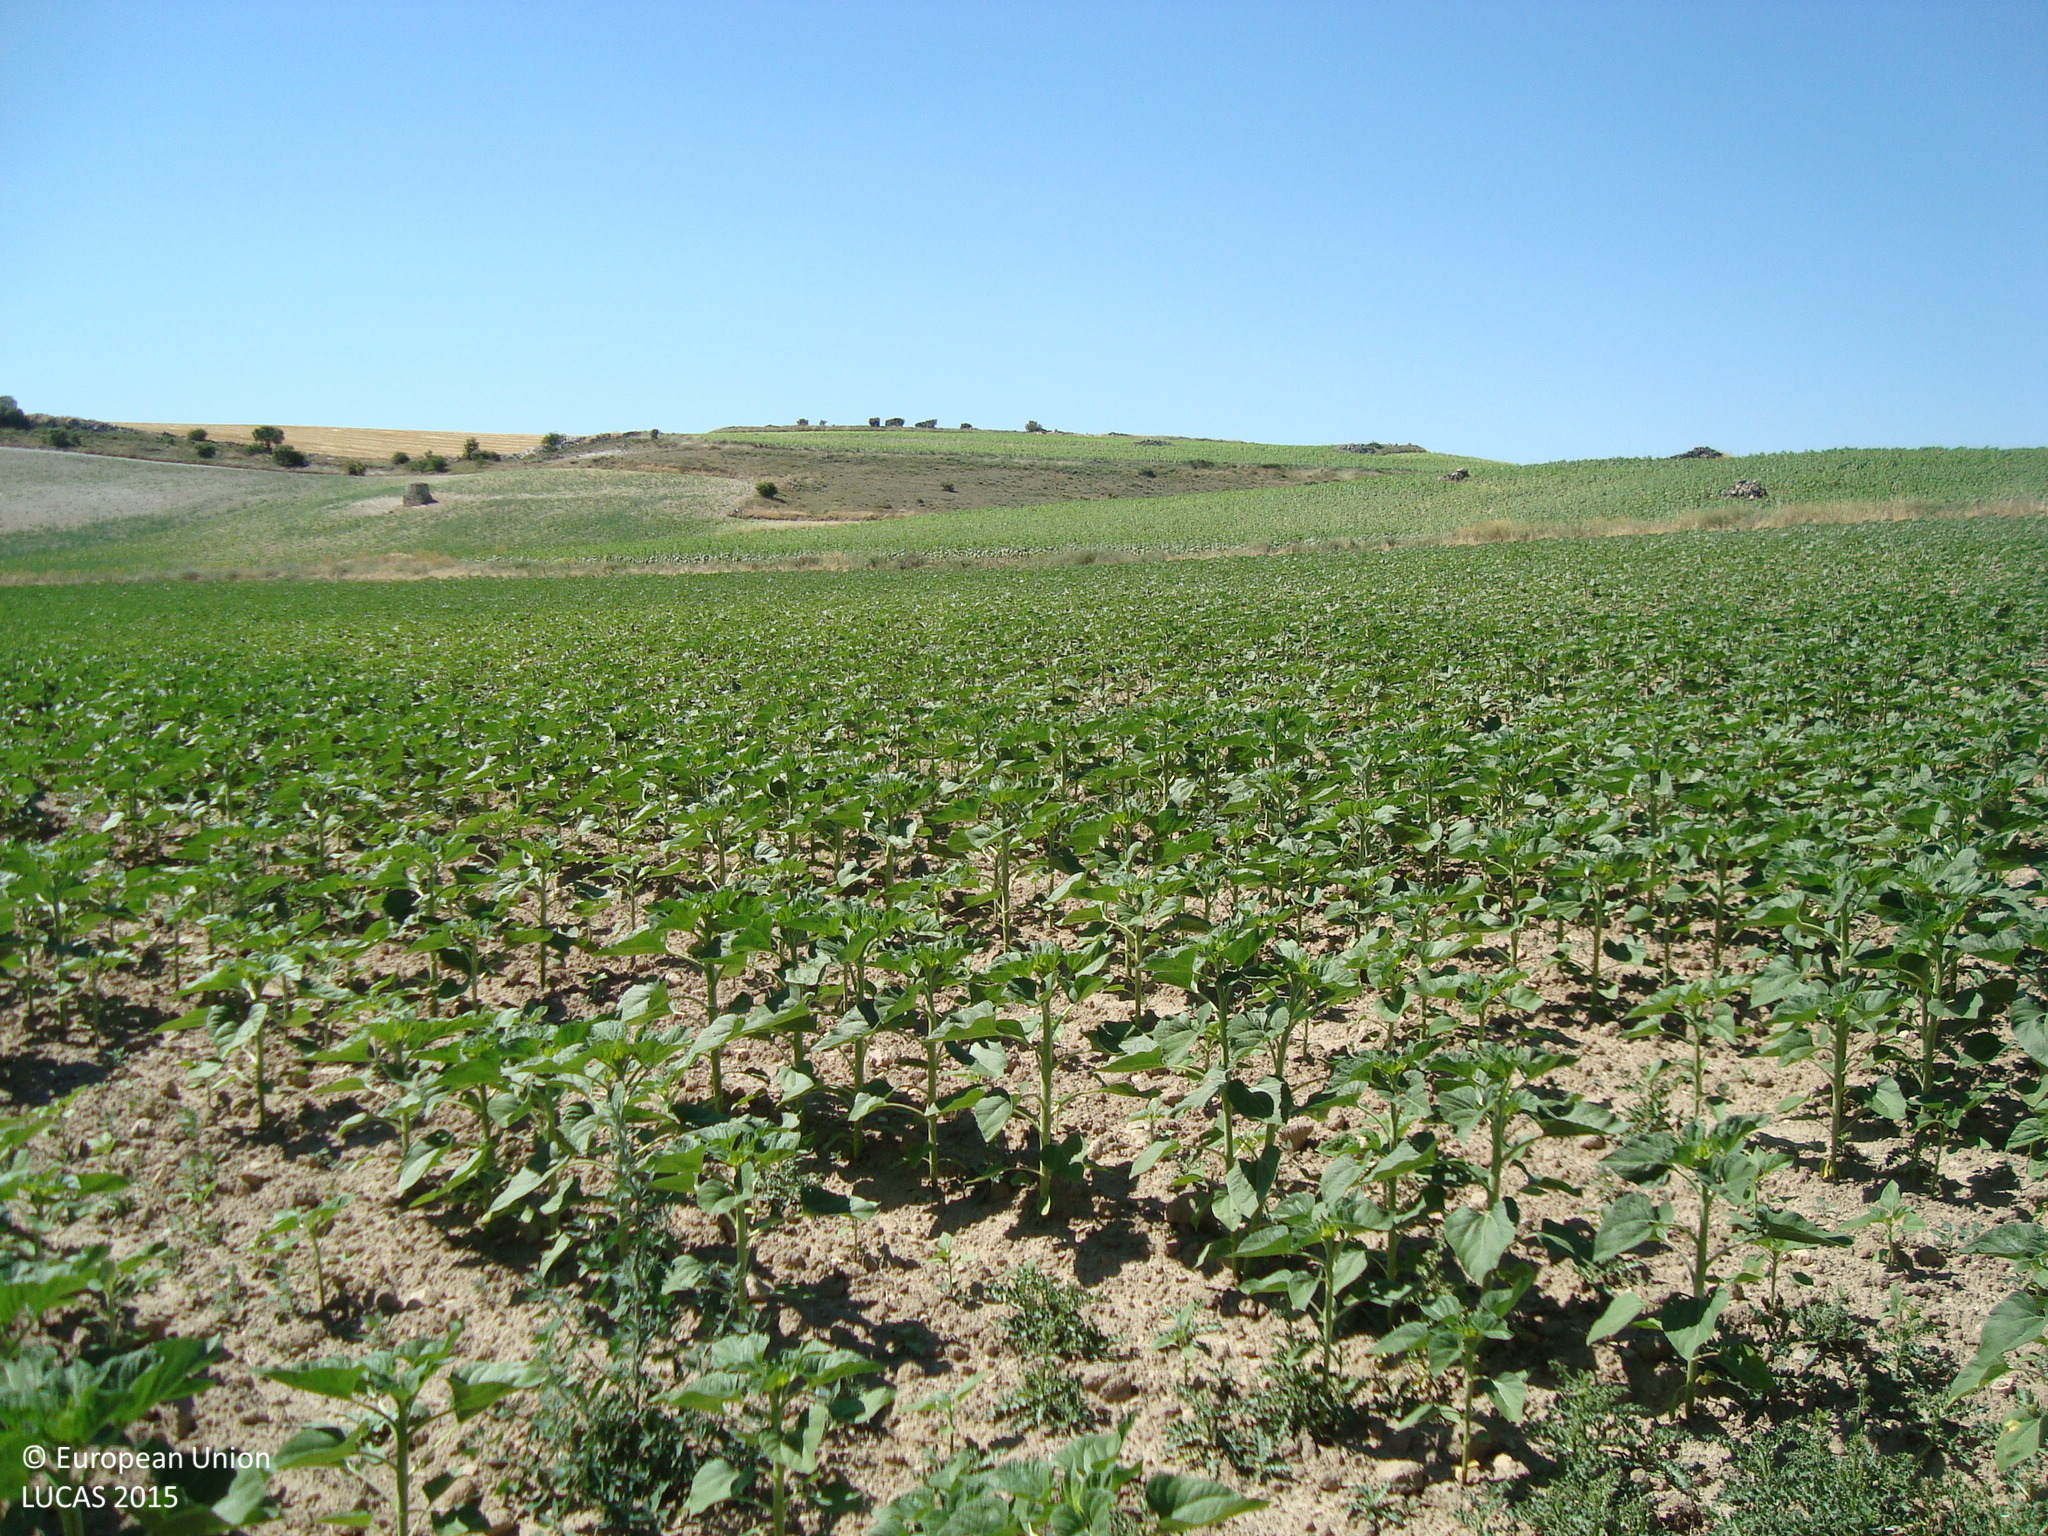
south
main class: Cropland
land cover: Sunflower
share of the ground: 50 - 75 %
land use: Agriculture (excluding fallow land and kitchen gardens)
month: July
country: ES
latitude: 41.6657
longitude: -4.0744
